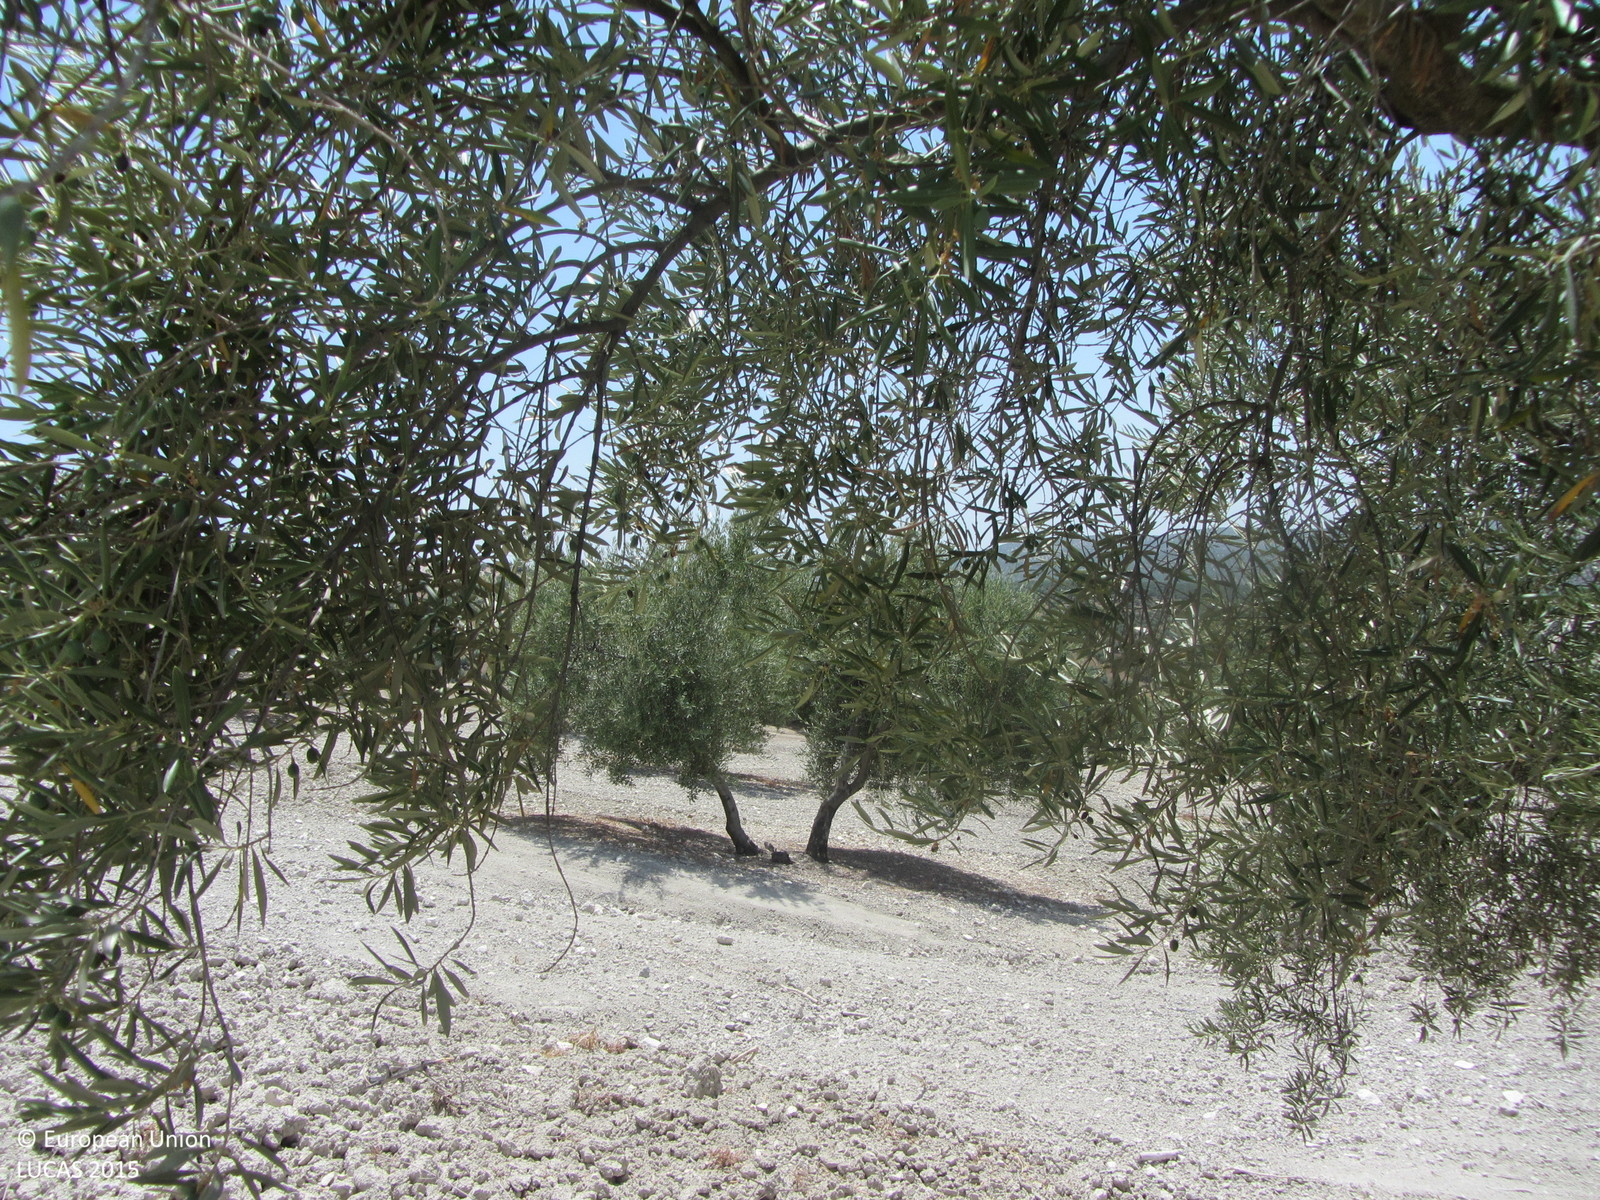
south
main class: Cropland
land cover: Olive groves
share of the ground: 25 - 50 %
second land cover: Other bare soil
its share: > 75 %
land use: Agriculture (excluding fallow land and kitchen gardens)
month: July
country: ES
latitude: 37.7484
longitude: -4.1569
